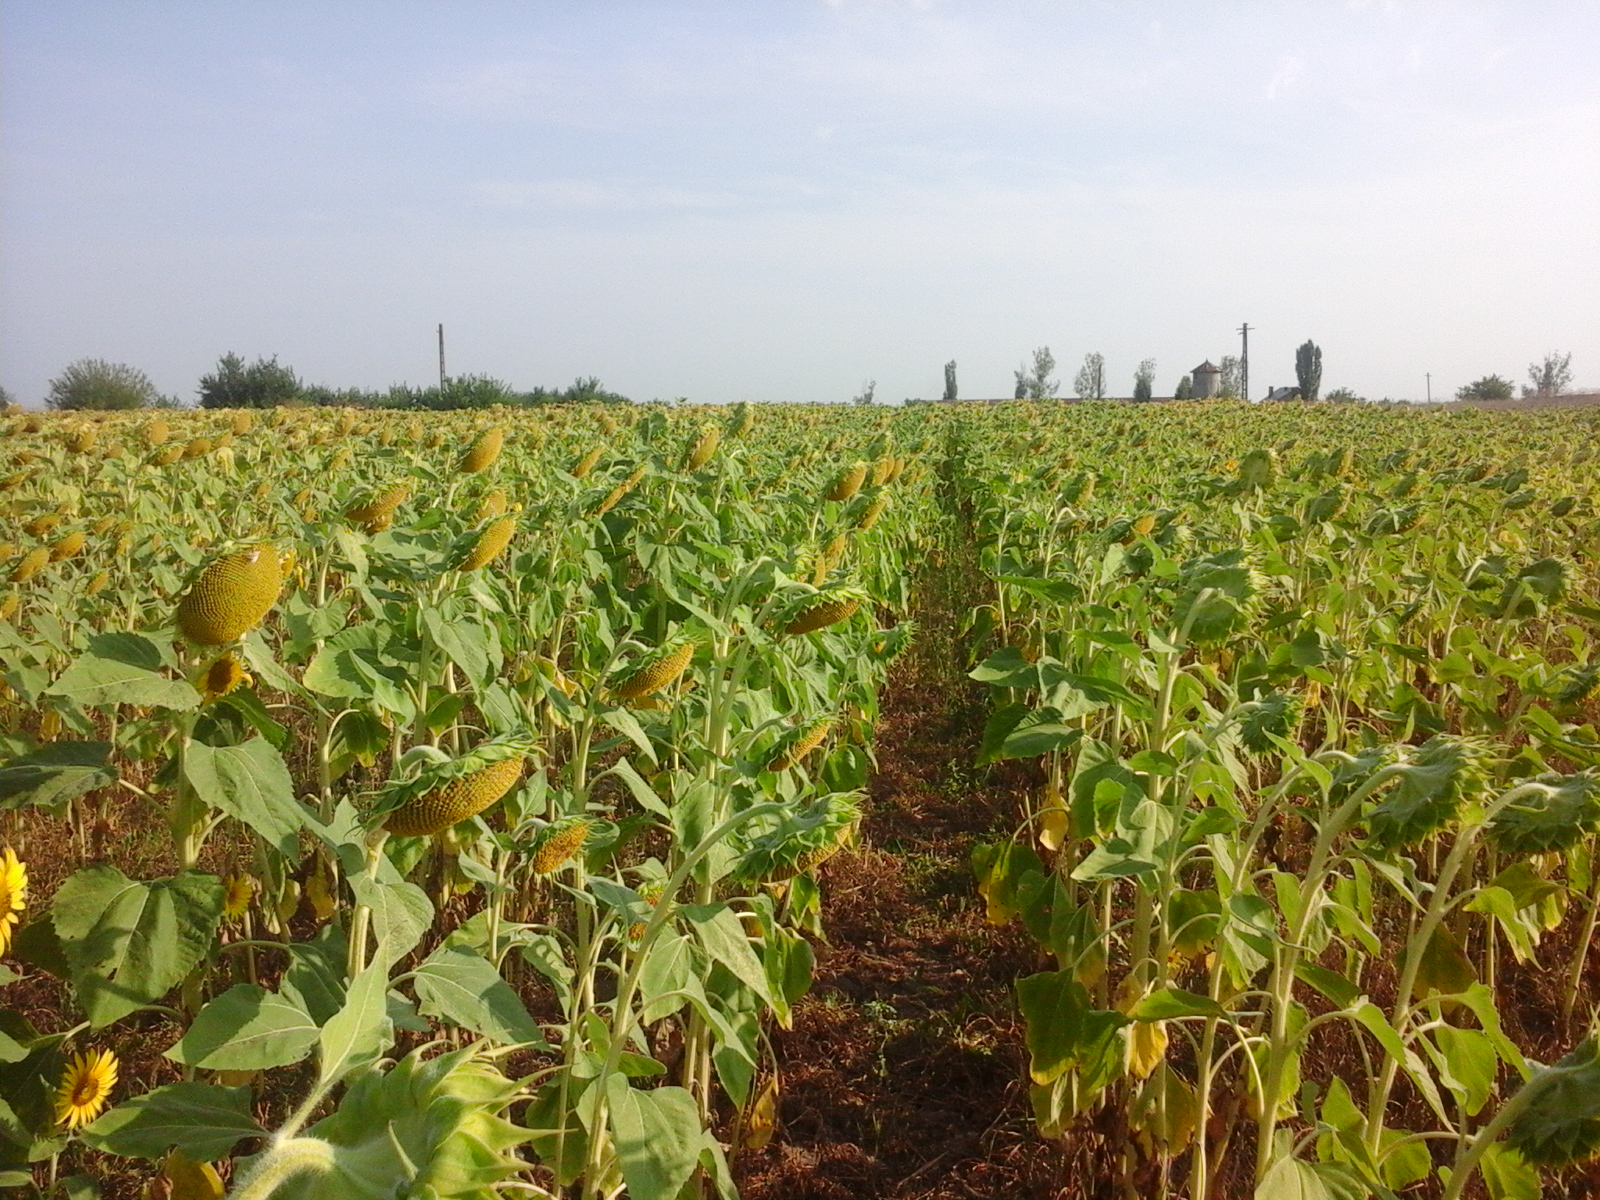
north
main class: Cropland
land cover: Sunflower
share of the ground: > 75 %
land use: Agriculture (excluding fallow land and kitchen gardens)
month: August
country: RO
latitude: 44.1681
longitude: 23.6981
